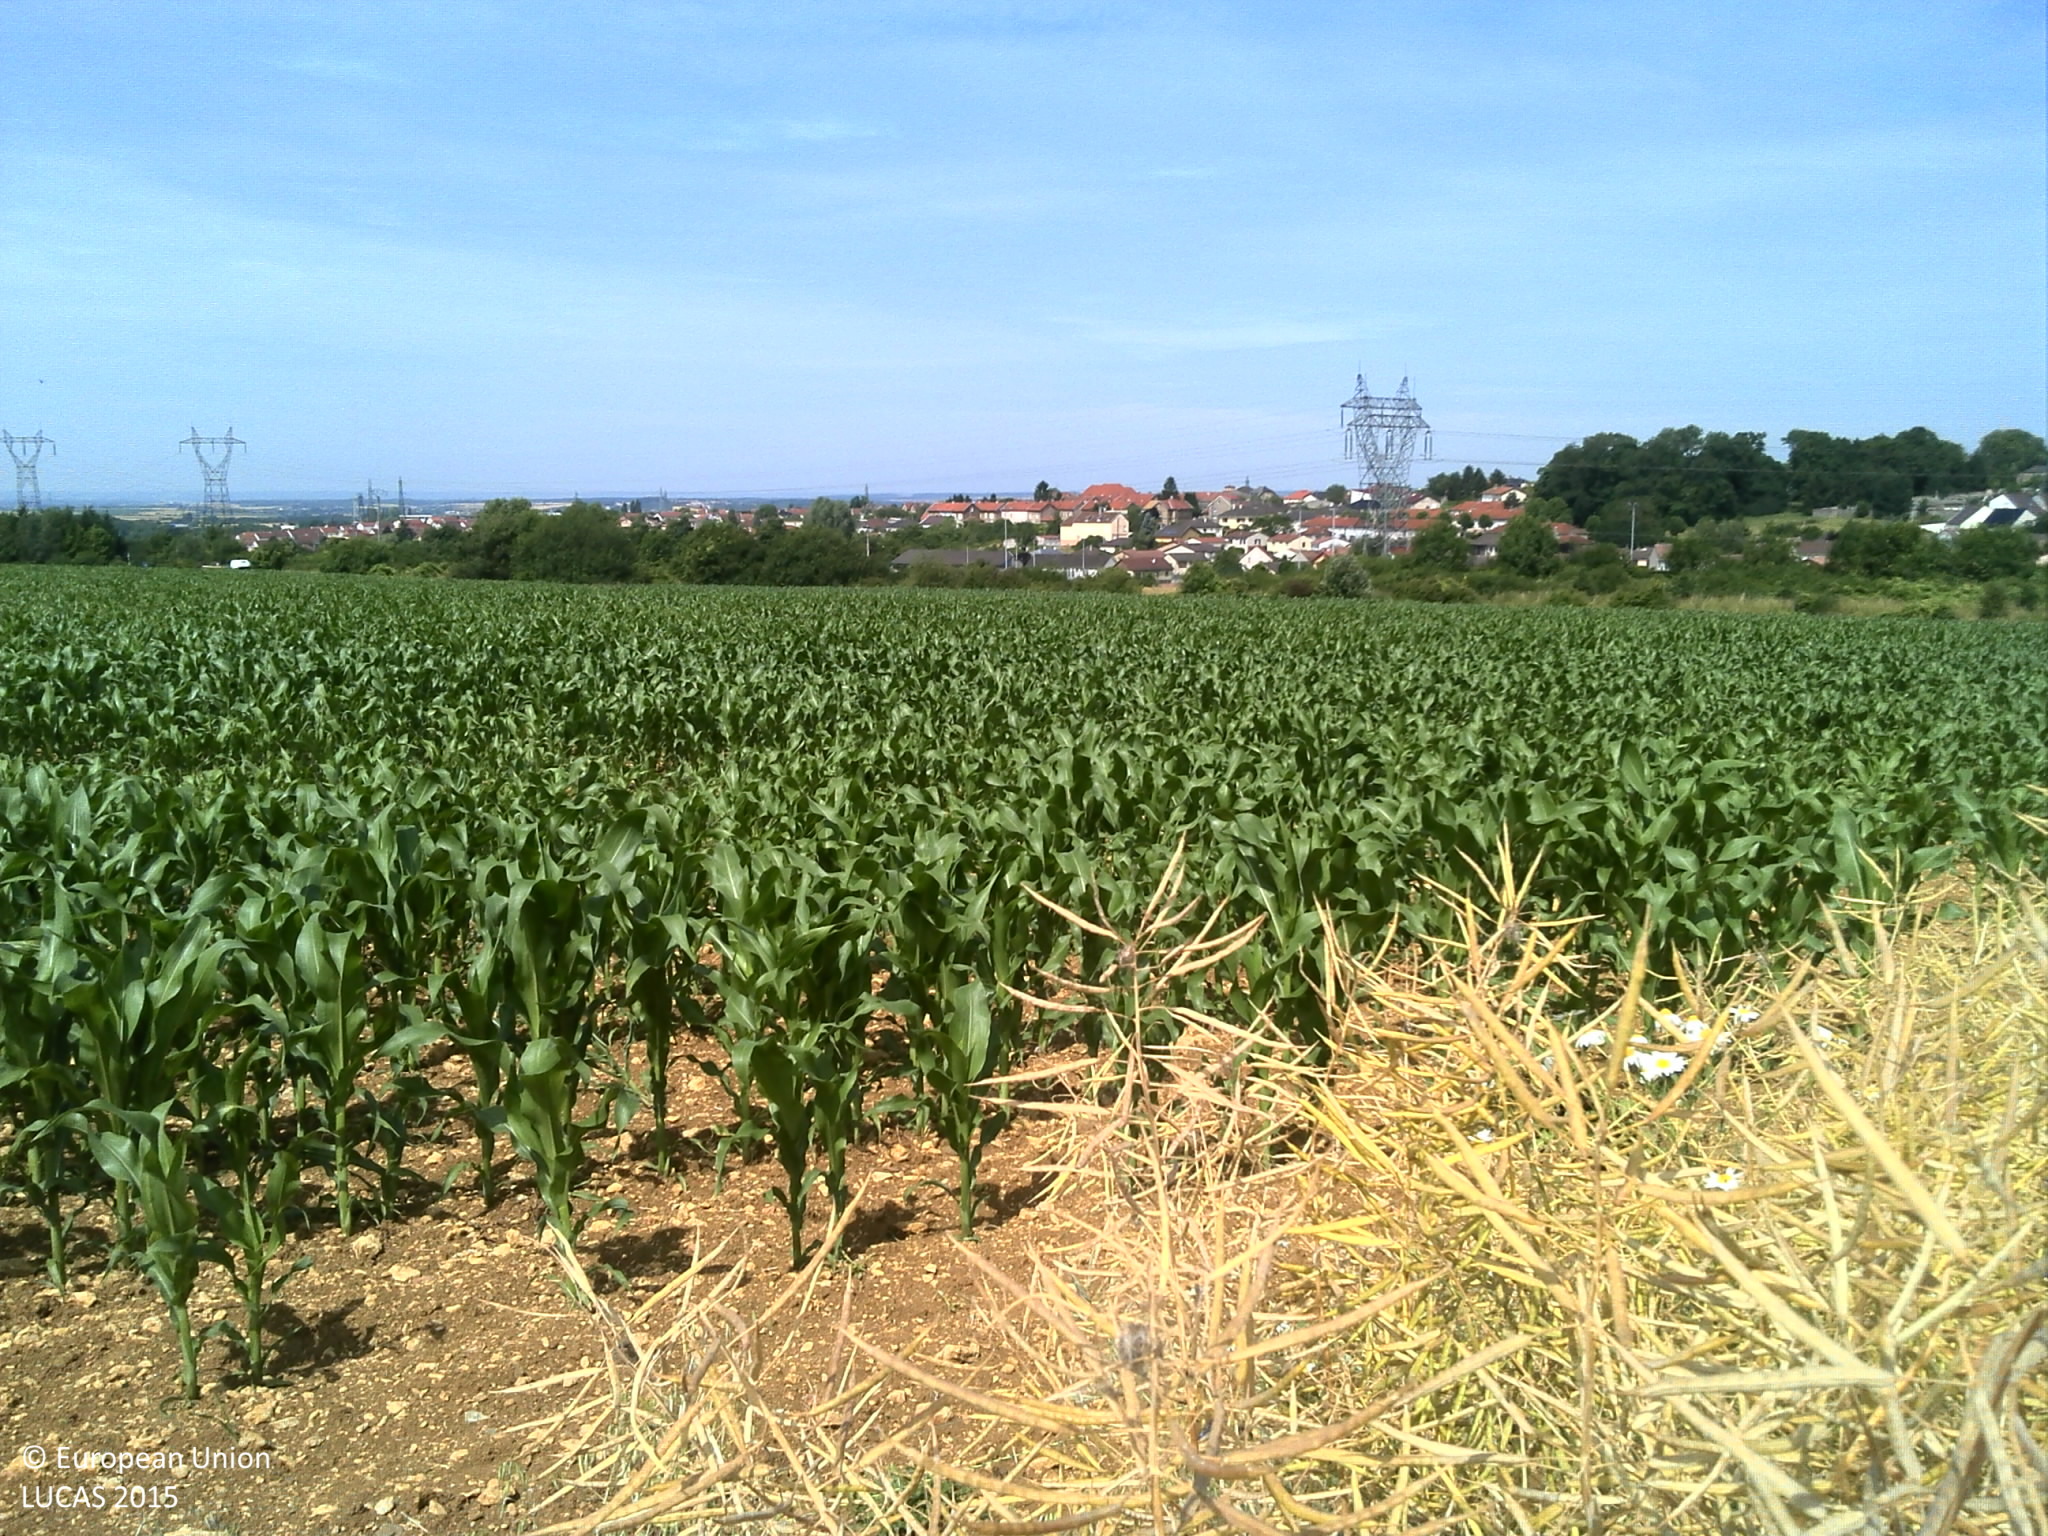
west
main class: Cropland
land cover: Rape and turnip rape
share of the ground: > 75 %
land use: Agriculture (excluding fallow land and kitchen gardens)
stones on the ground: > 50 %
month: June
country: FR
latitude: 49.2149
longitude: 6.0320
